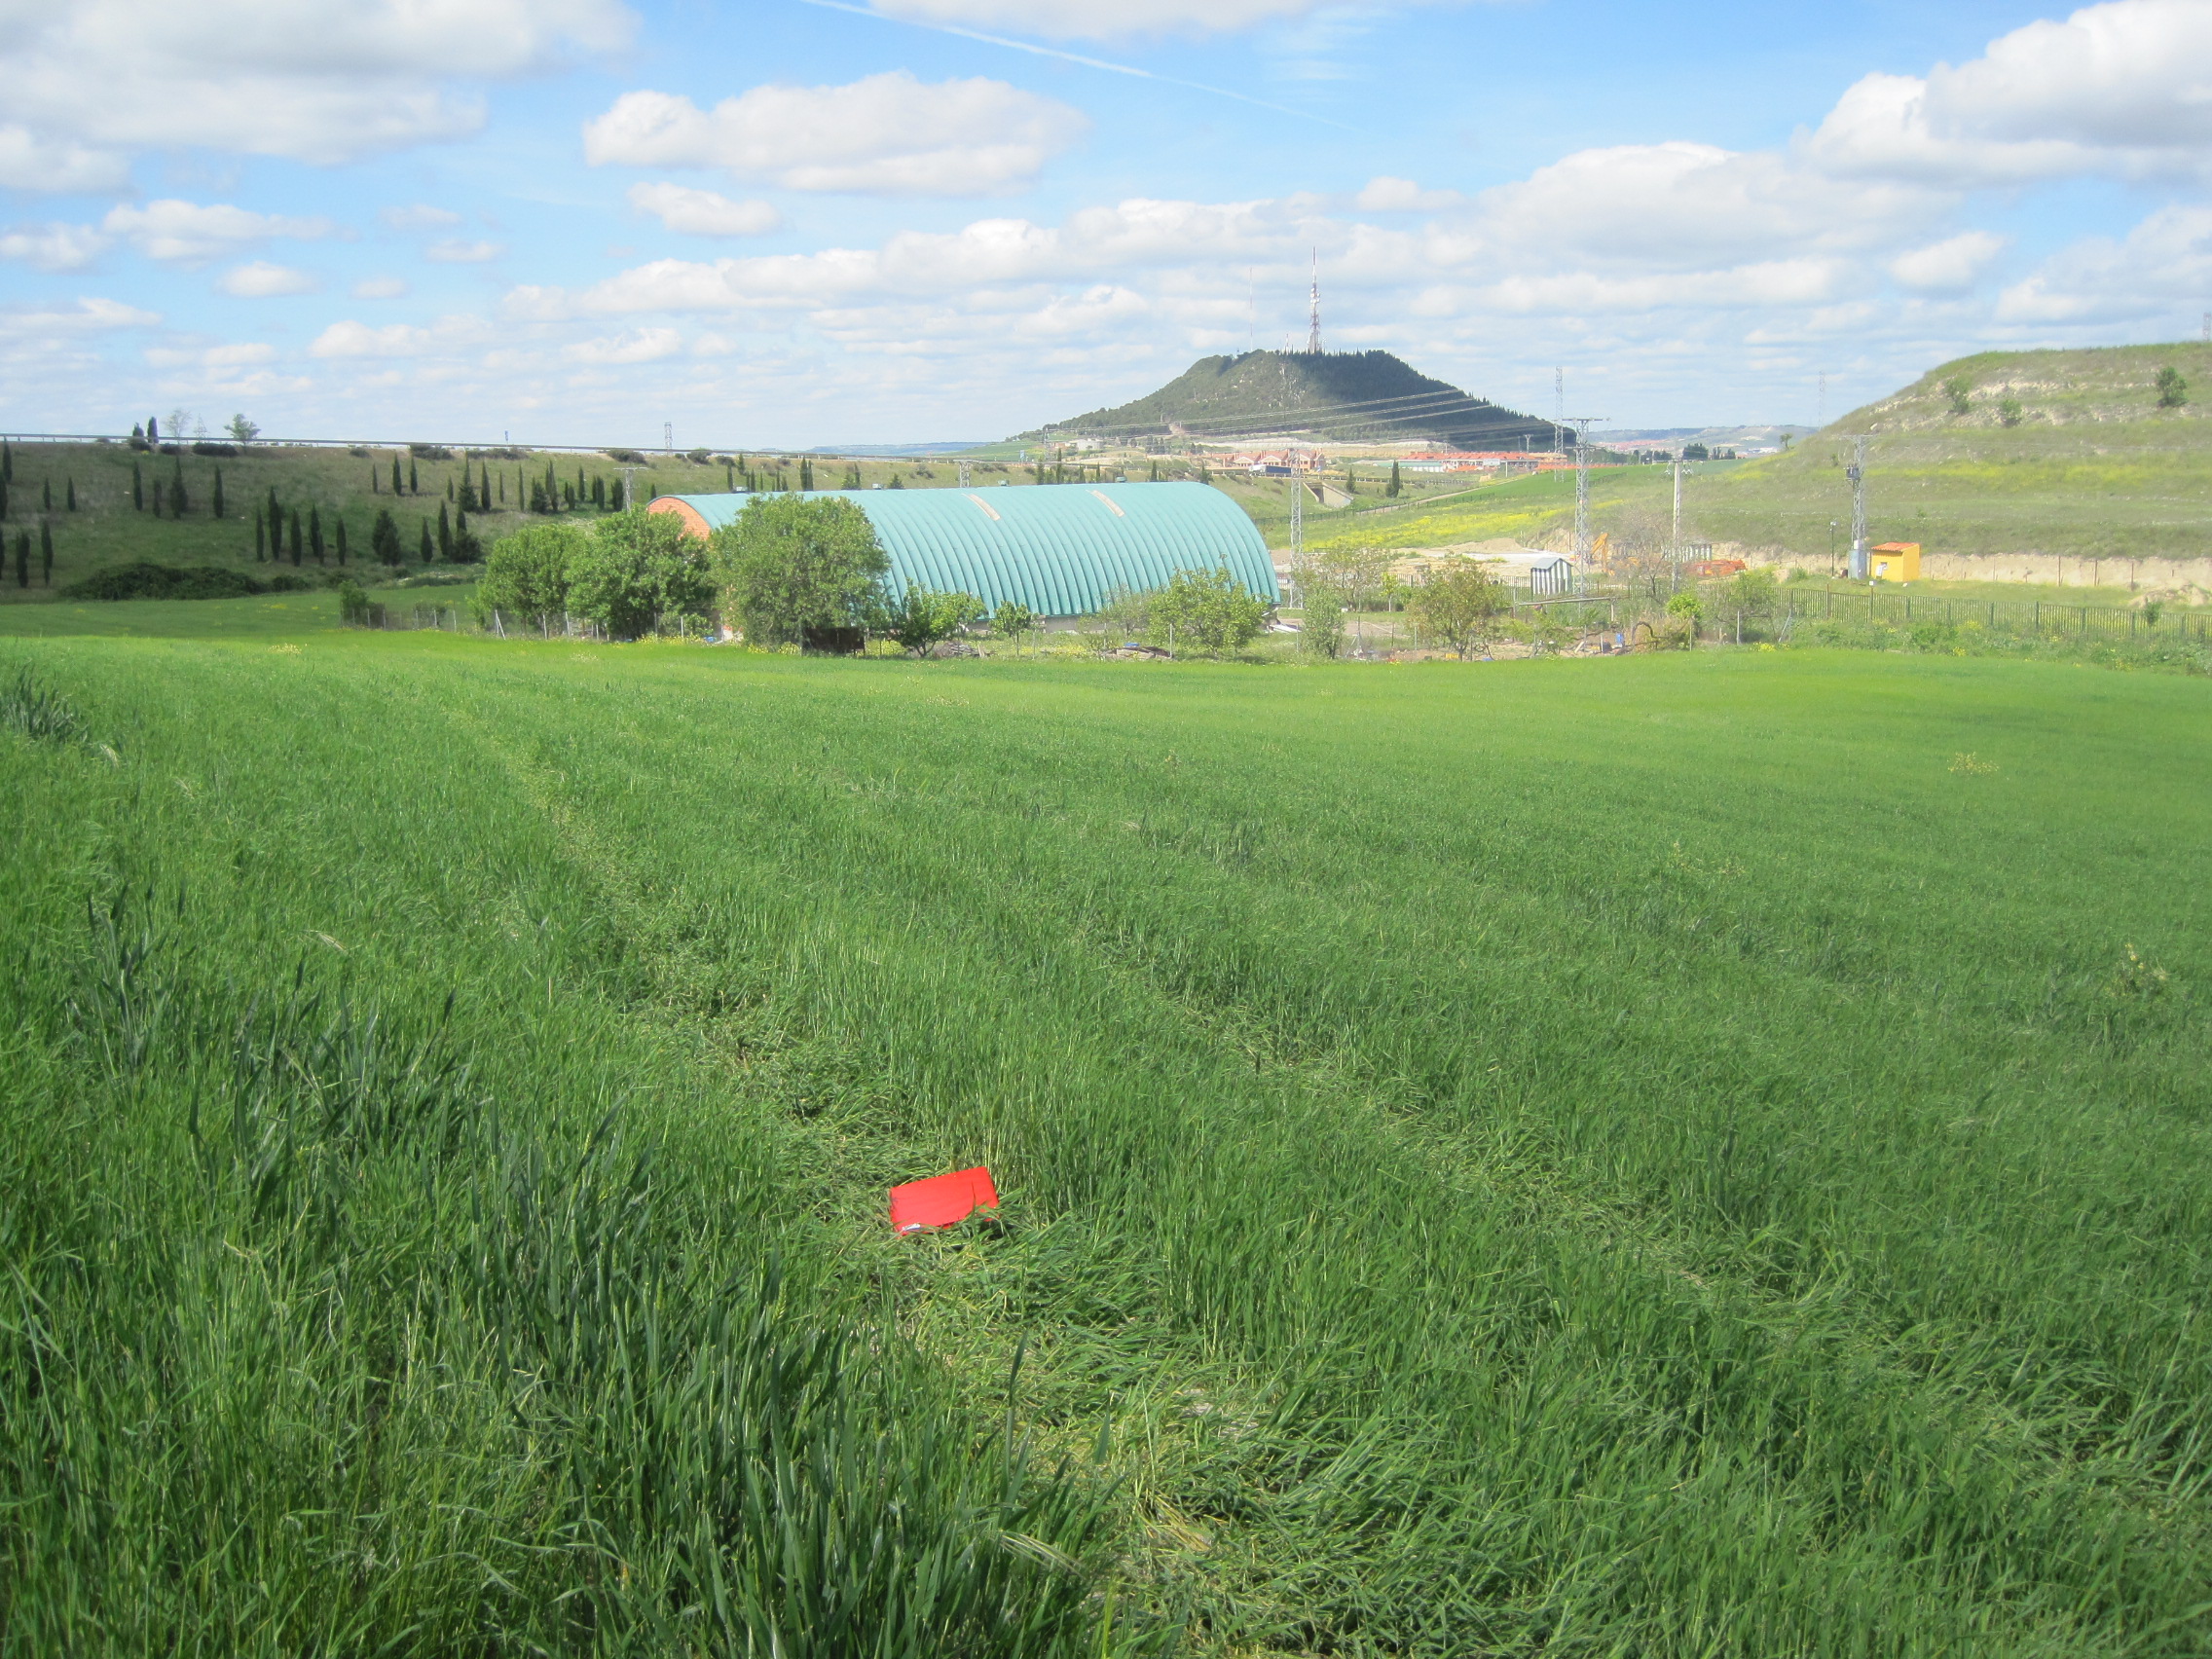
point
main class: Cropland
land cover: Barley
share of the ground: > 75 %
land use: Agriculture (excluding fallow land and kitchen gardens)
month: May
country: ES
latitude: 41.6155
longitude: -4.6727
